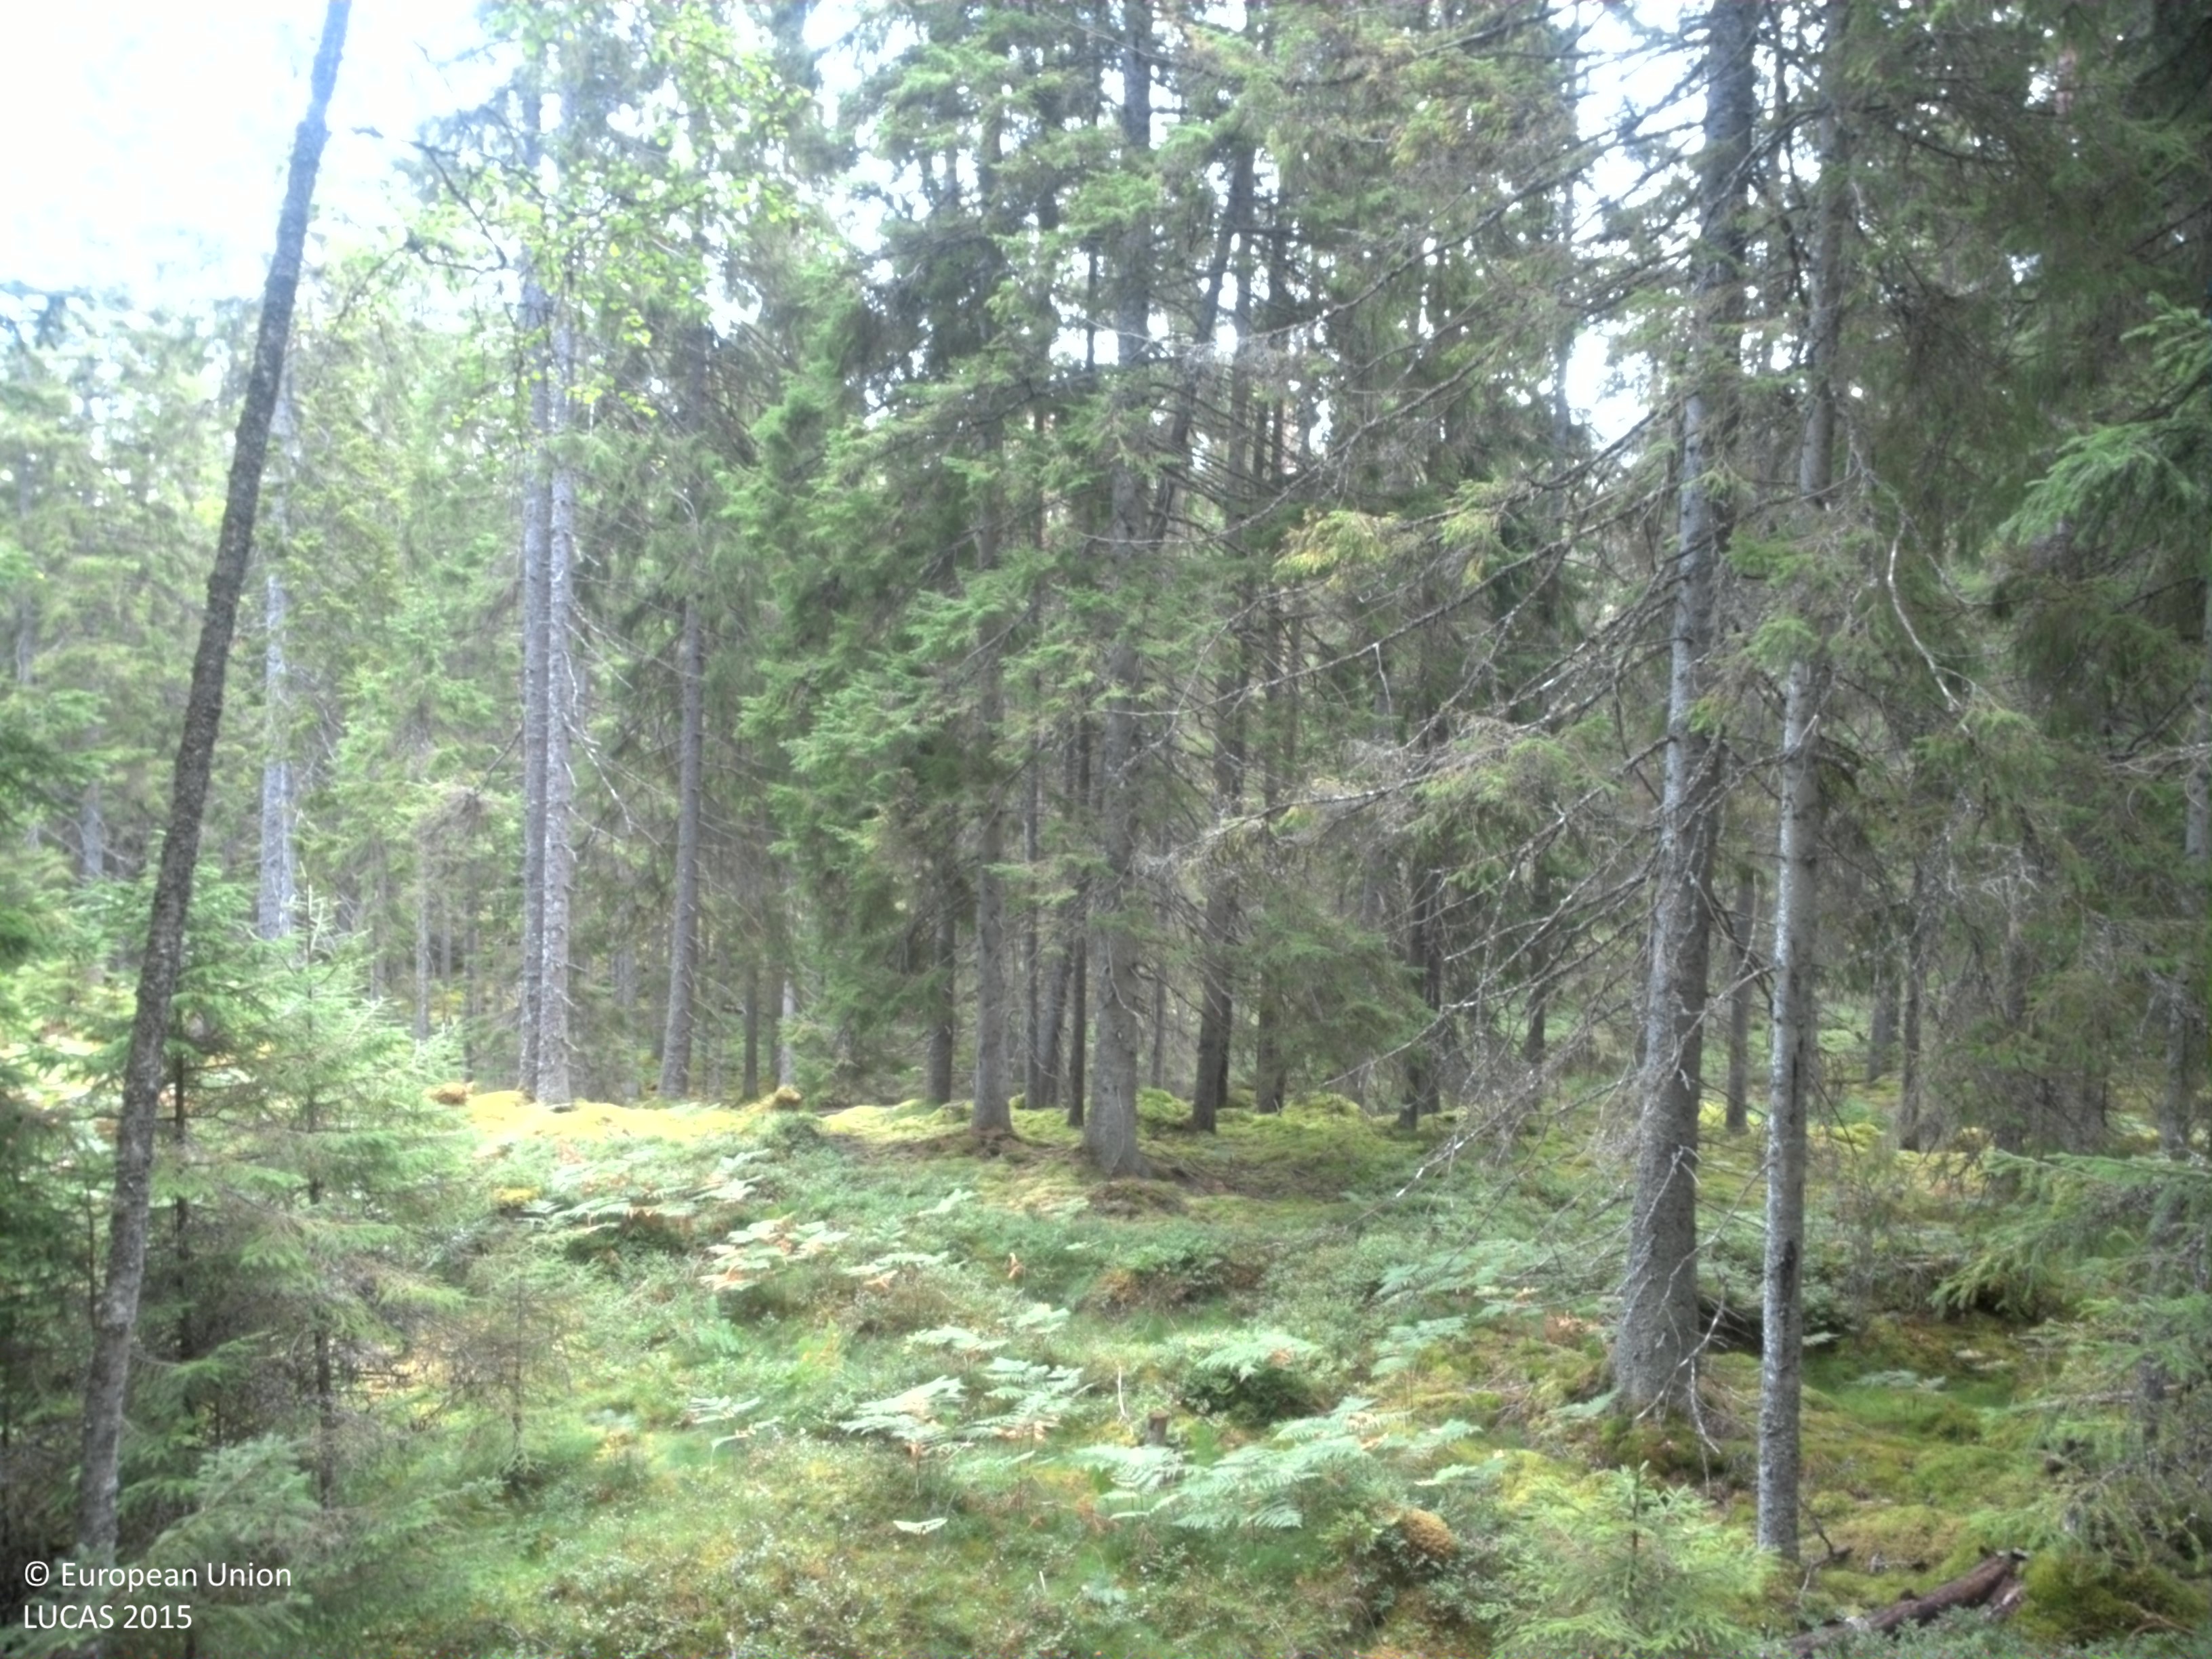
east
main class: Woodland
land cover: Spruce dominated coniferous woodland
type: boreal forest
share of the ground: 50 - 75 %
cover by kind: coniferous forest trees 50 %, lichens and mosses 35 %, shrubs 10 %, broadleaved forest trees 5 %
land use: Forestry
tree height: > 5 m
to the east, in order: Spruce dominated coniferous woodland; Pine dominated coniferous woodland; Spruce dominated coniferous woodland; Paved roads, cycling and walking lanes; Spruce dominated coniferous woodland
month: August
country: SE
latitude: 57.8193
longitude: 13.9510
